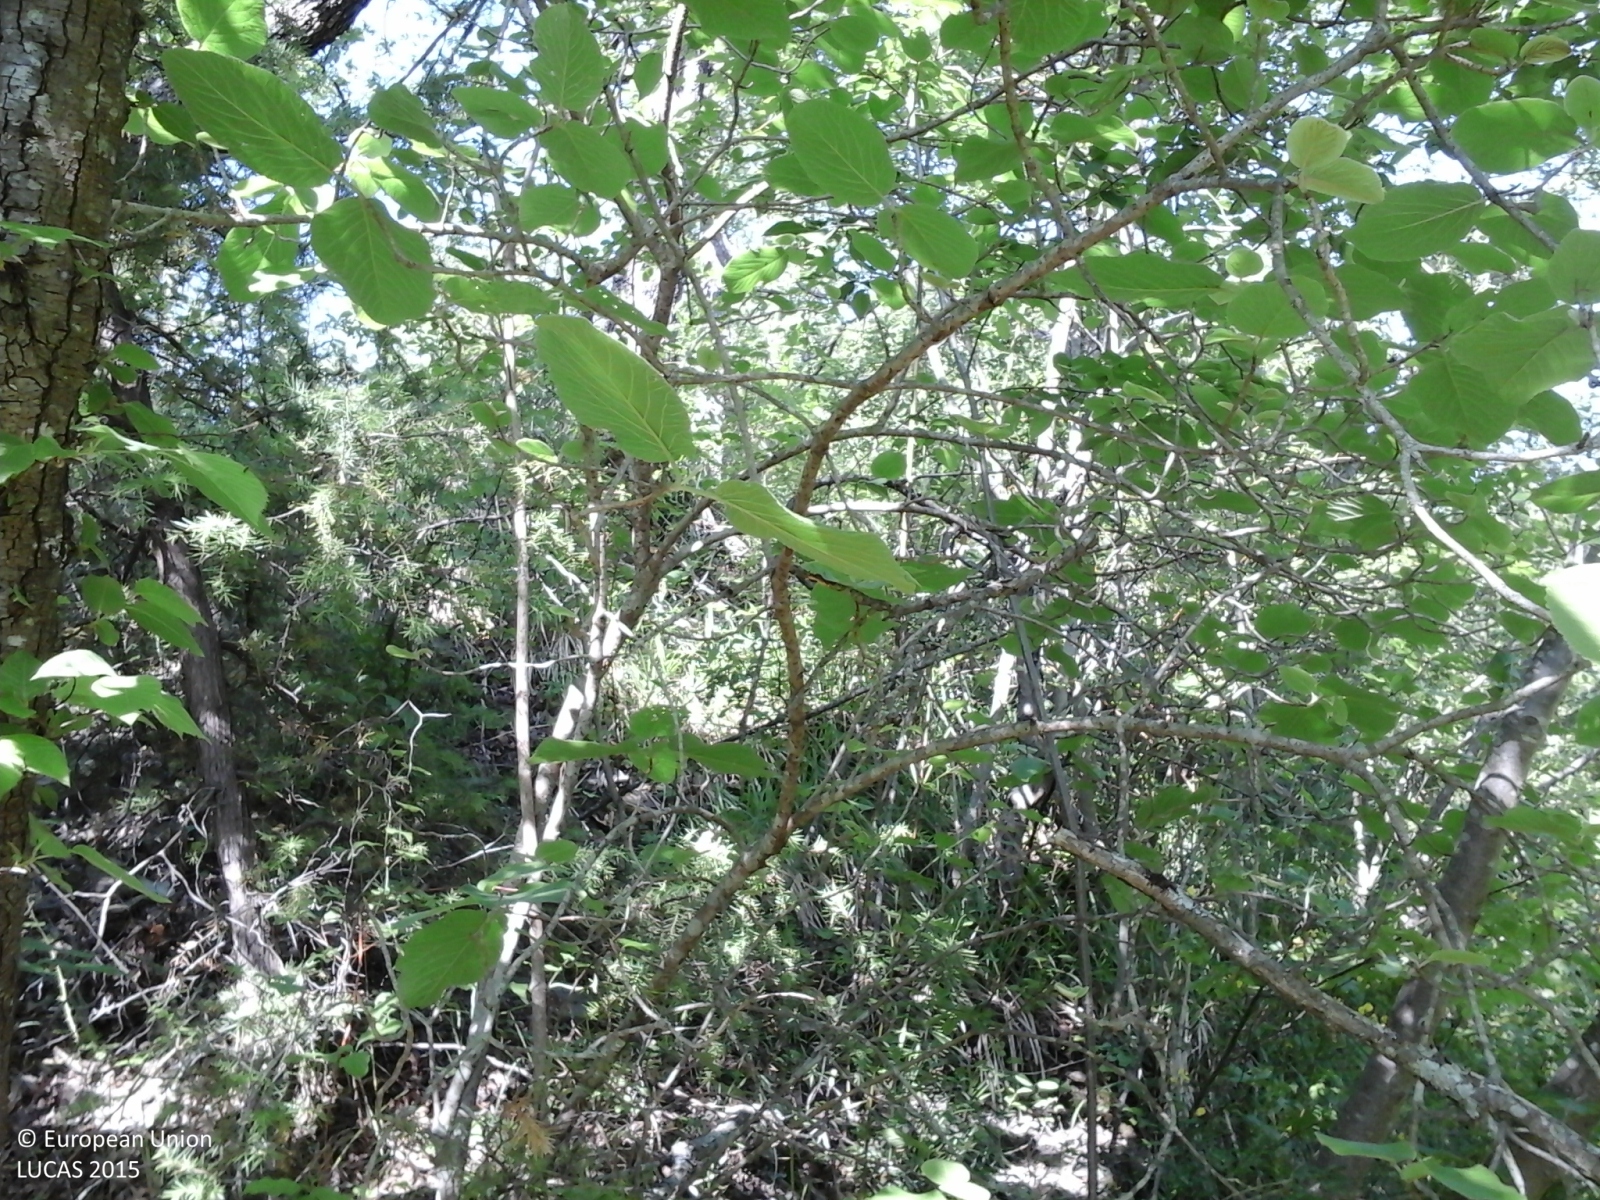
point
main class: Woodland
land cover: Broadleaved woodland
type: thermophilous deciduous forest
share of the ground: > 75 %
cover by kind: broadleaved forest trees 100 %
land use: Forestry
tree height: > 5 m
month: May
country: IT
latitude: 44.6210
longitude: 9.8868
